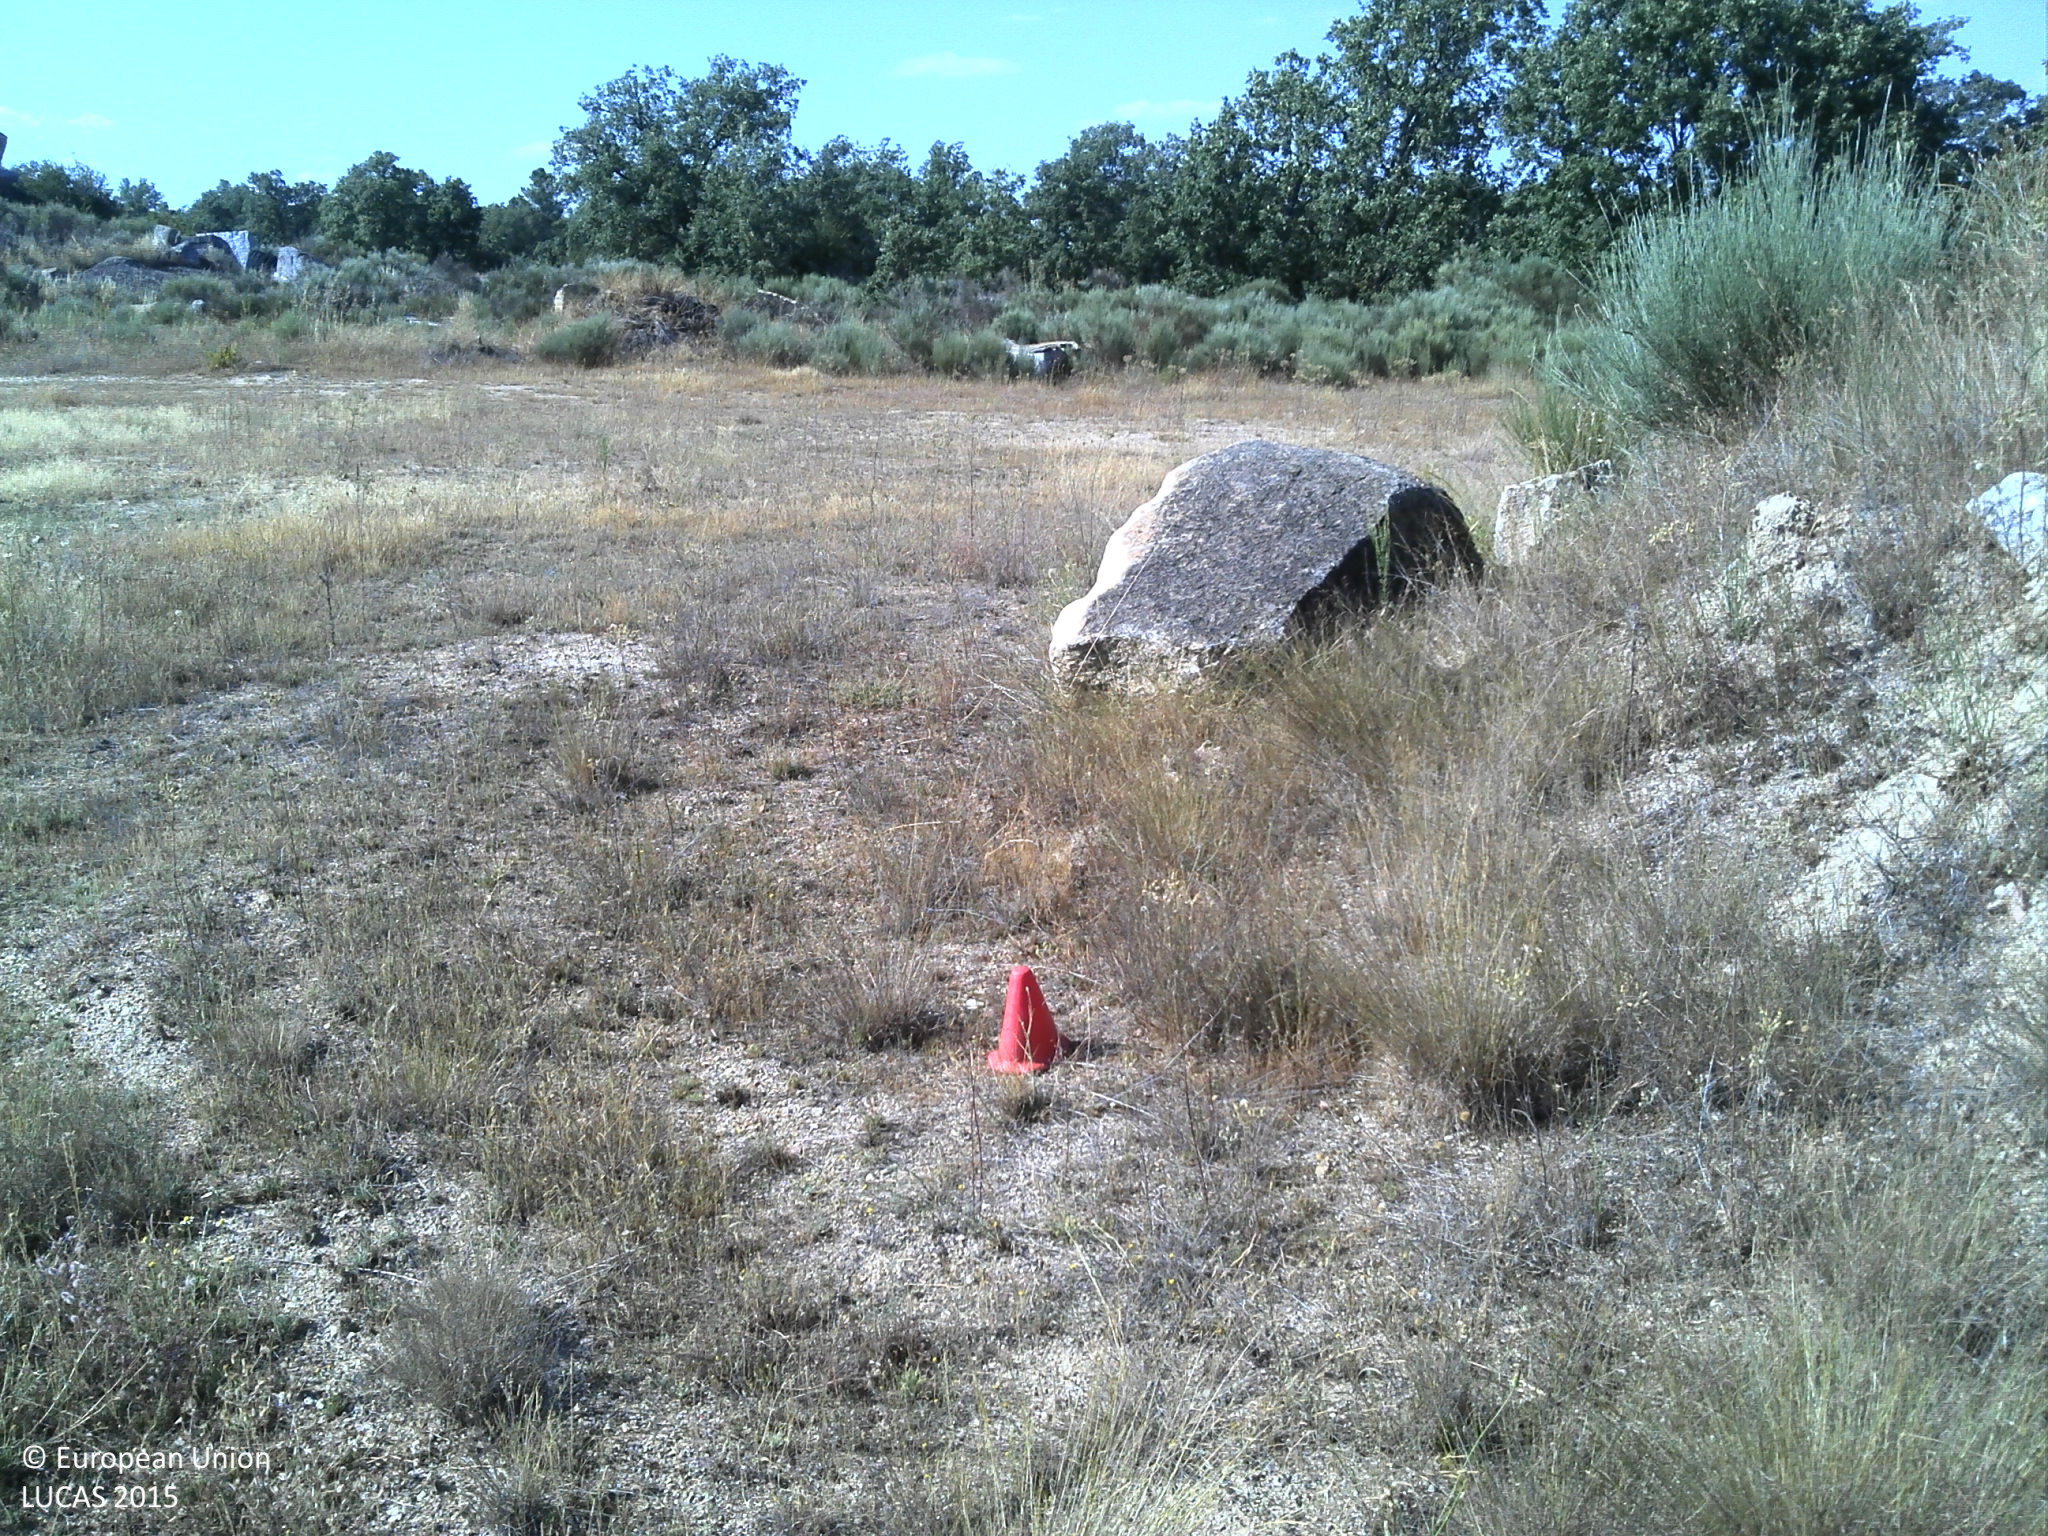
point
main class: Shrubland
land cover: Shrubland without tree cover
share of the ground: 25 - 50 %
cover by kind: unconsolidated bare surface 40 %, herbaceous plants 30 %, shrubs 25 %, consolidated bare surface 5 %
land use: Abandoned areas
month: June
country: PT
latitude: 40.7677
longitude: -6.8634
